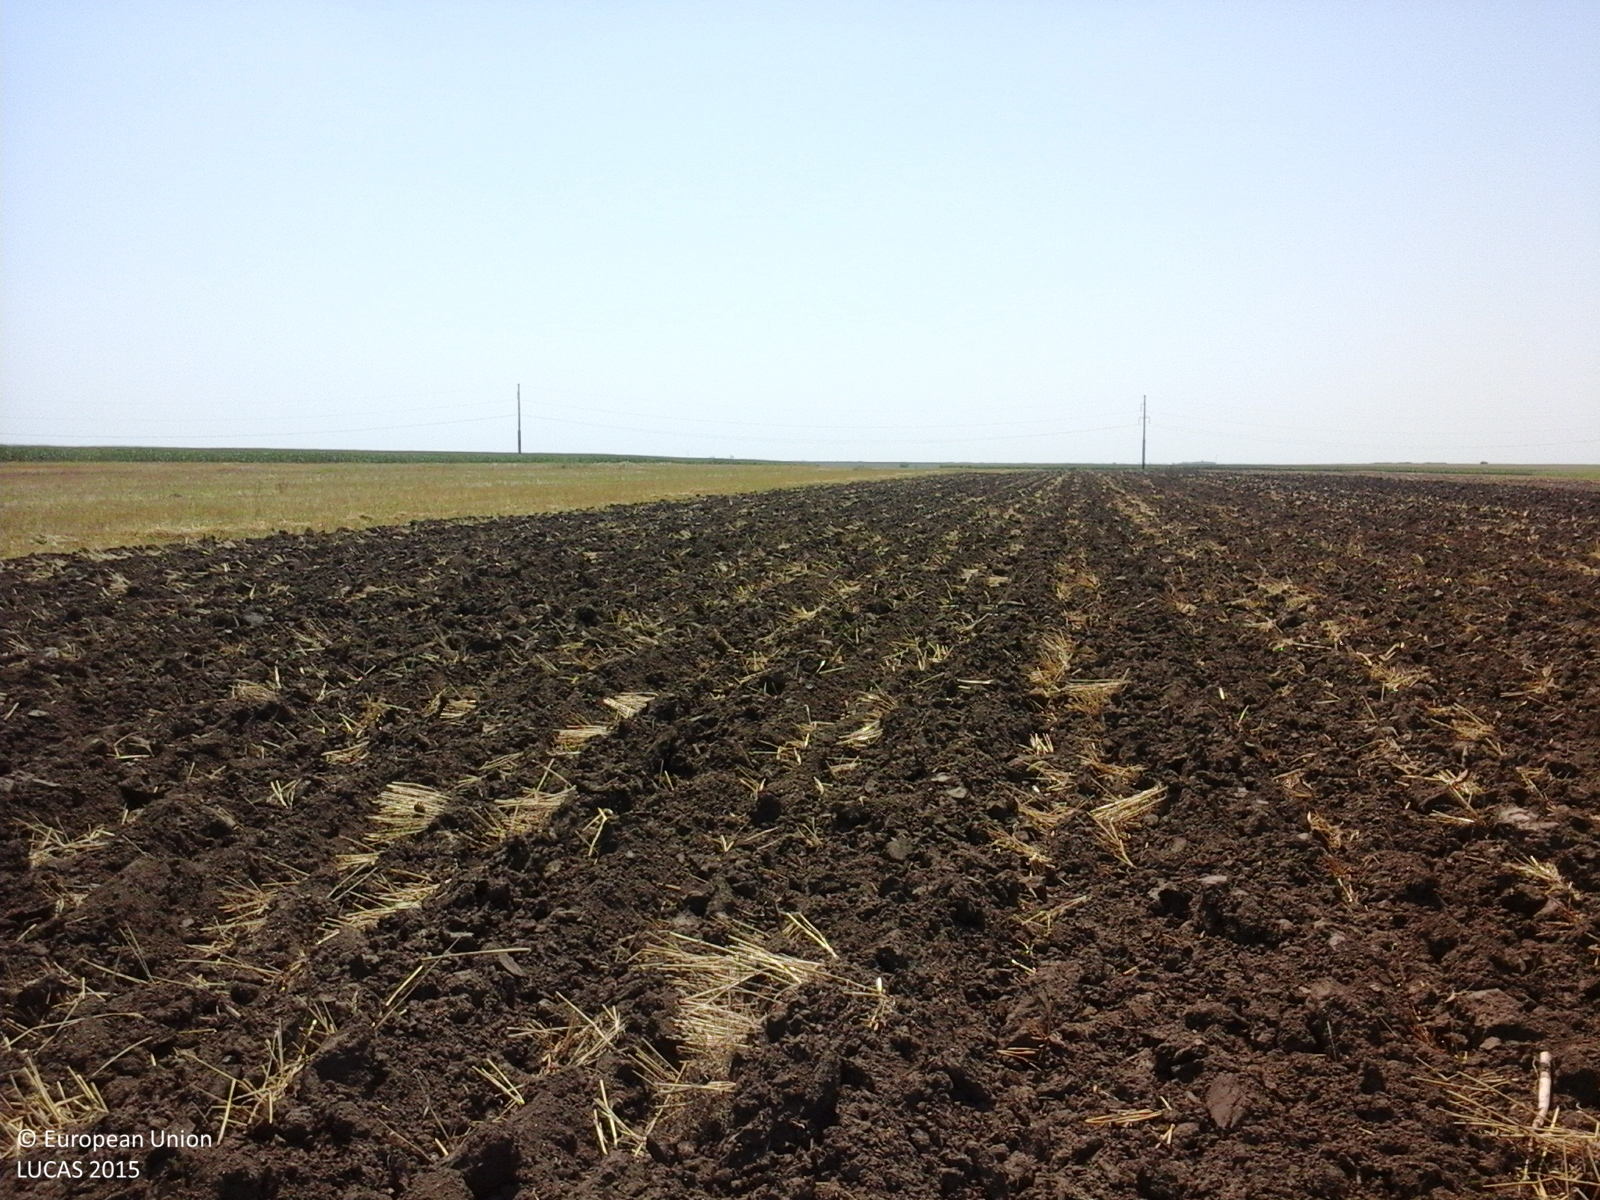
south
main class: Cropland
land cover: Common wheat
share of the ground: < 10 %
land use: Agriculture (excluding fallow land and kitchen gardens)
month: July
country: RO
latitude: 44.5015
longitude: 26.7623
